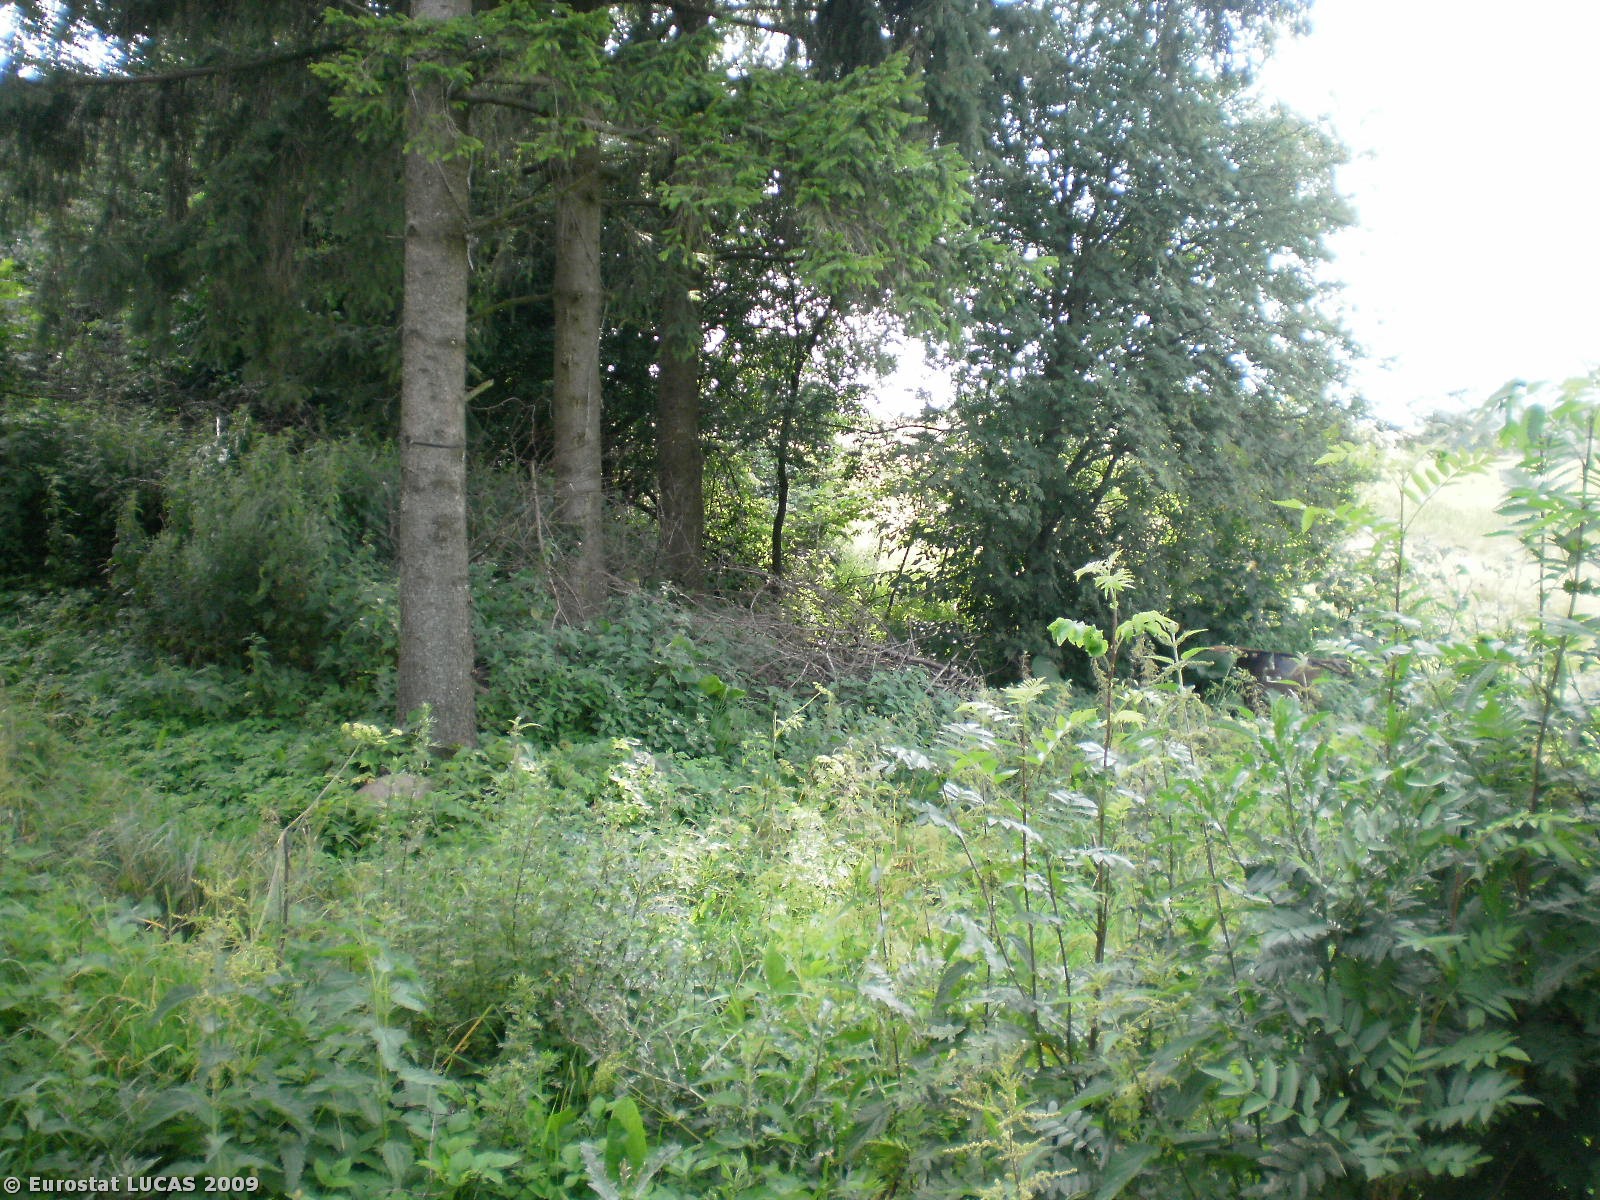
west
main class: Woodland
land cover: Broadleaved woodland
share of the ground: > 75 %
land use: Residential
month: July
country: PL
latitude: 53.9336
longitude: 20.5931
